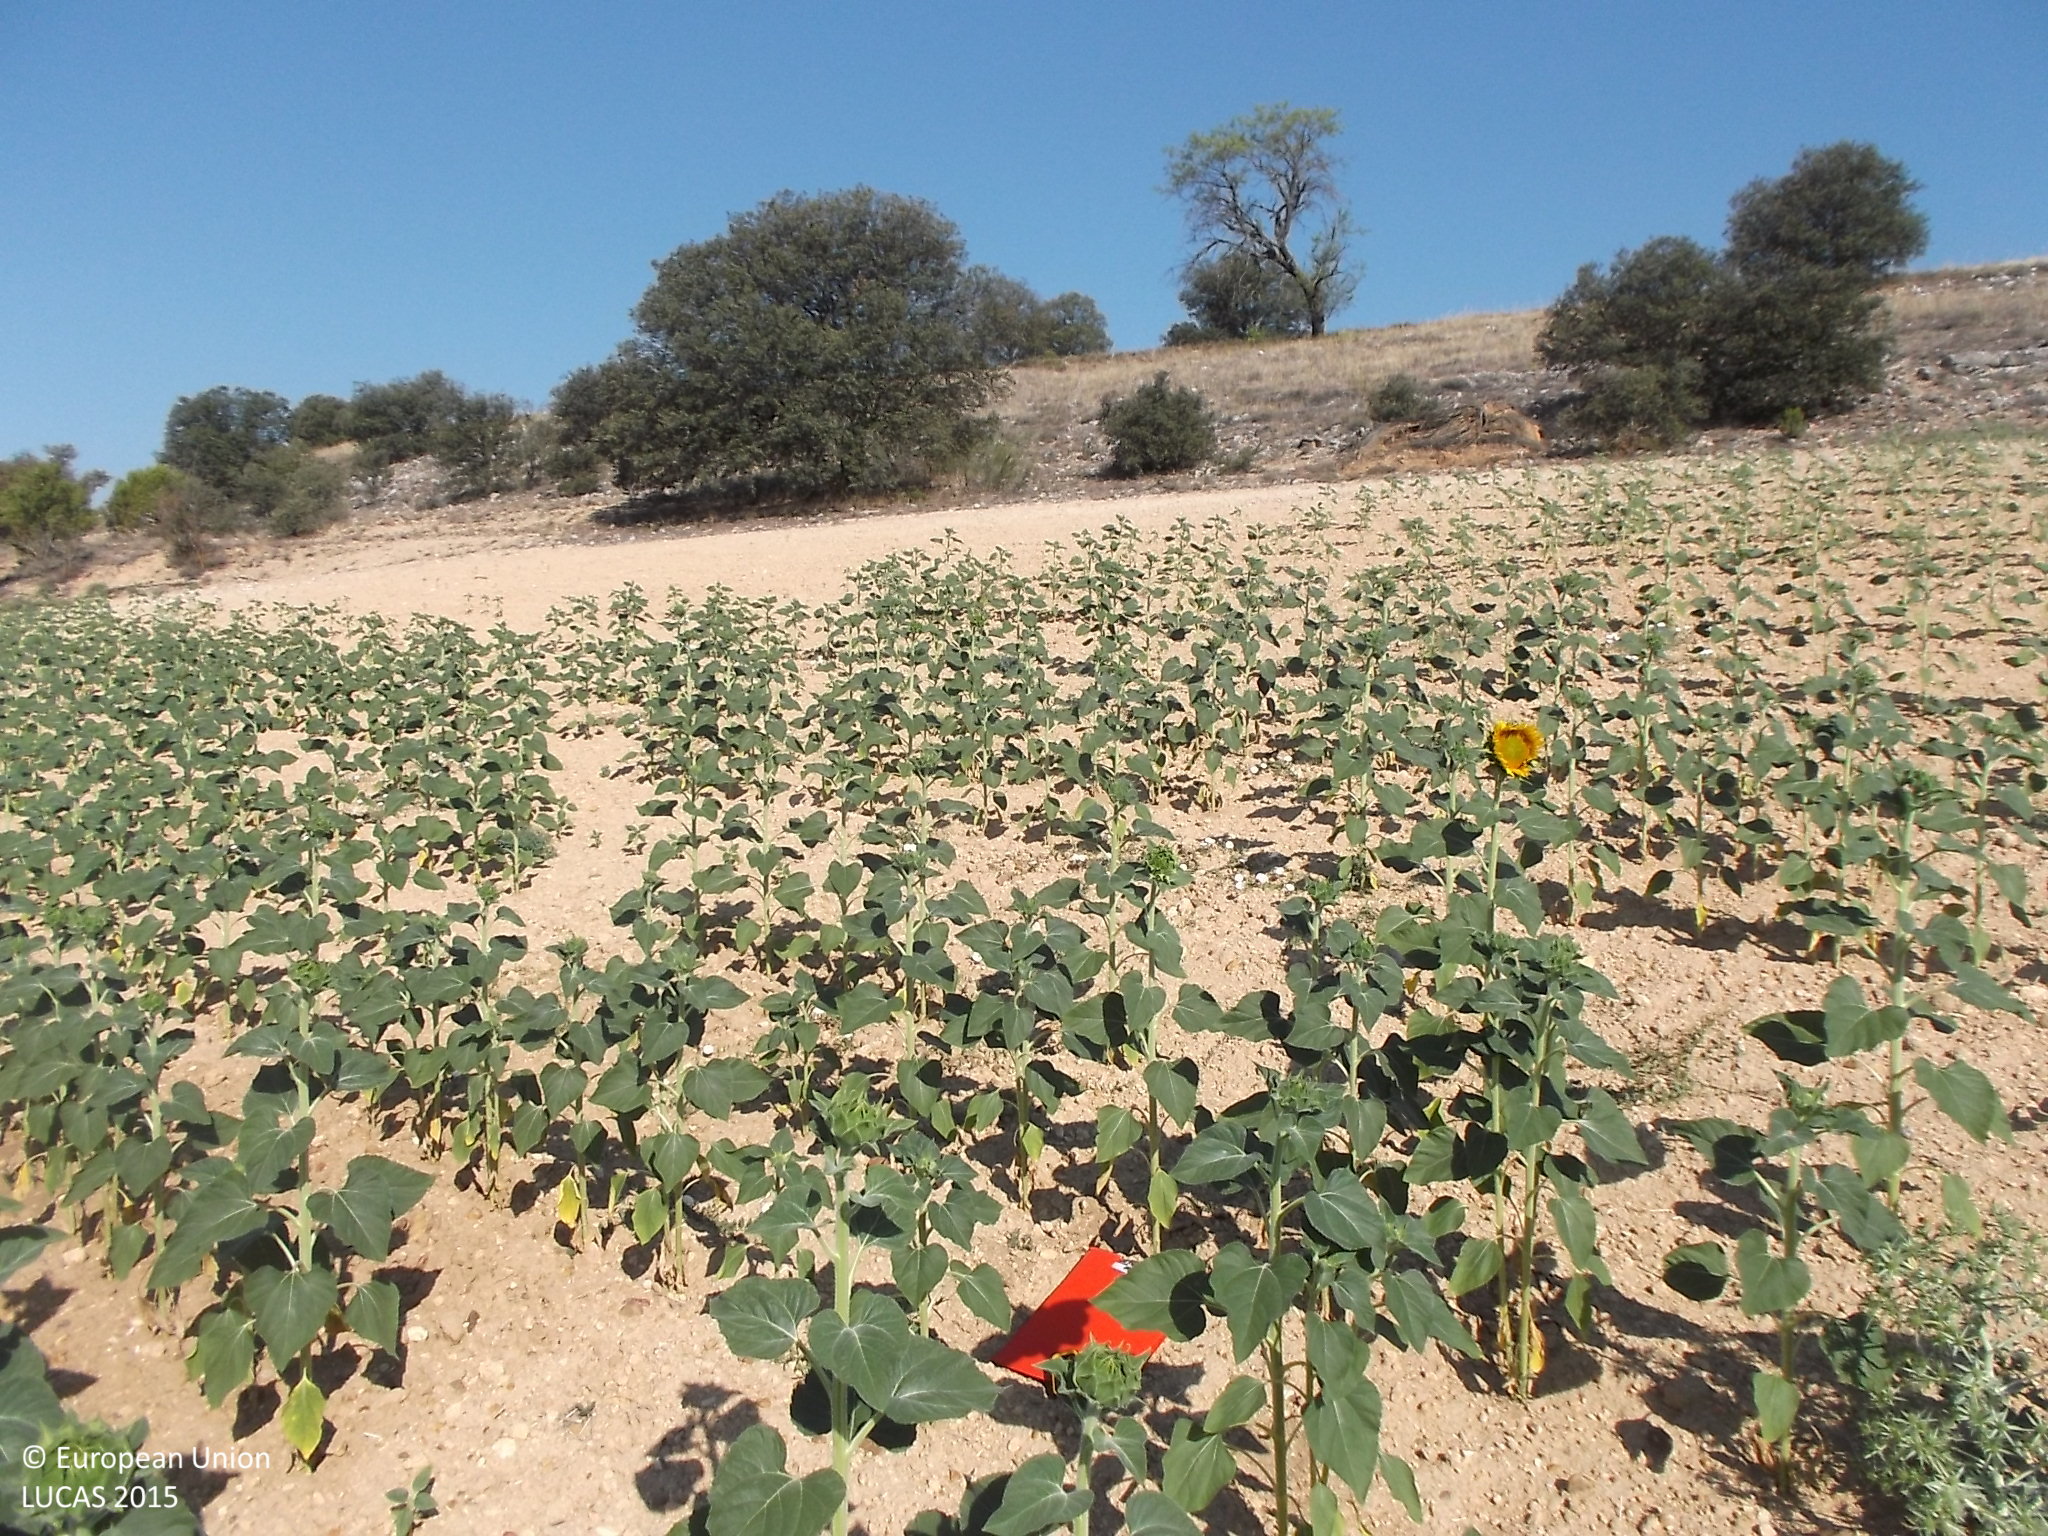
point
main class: Cropland
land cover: Sunflower
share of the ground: > 75 %
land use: Agriculture (excluding fallow land and kitchen gardens)
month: July
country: ES
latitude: 41.4125
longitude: -5.4035
